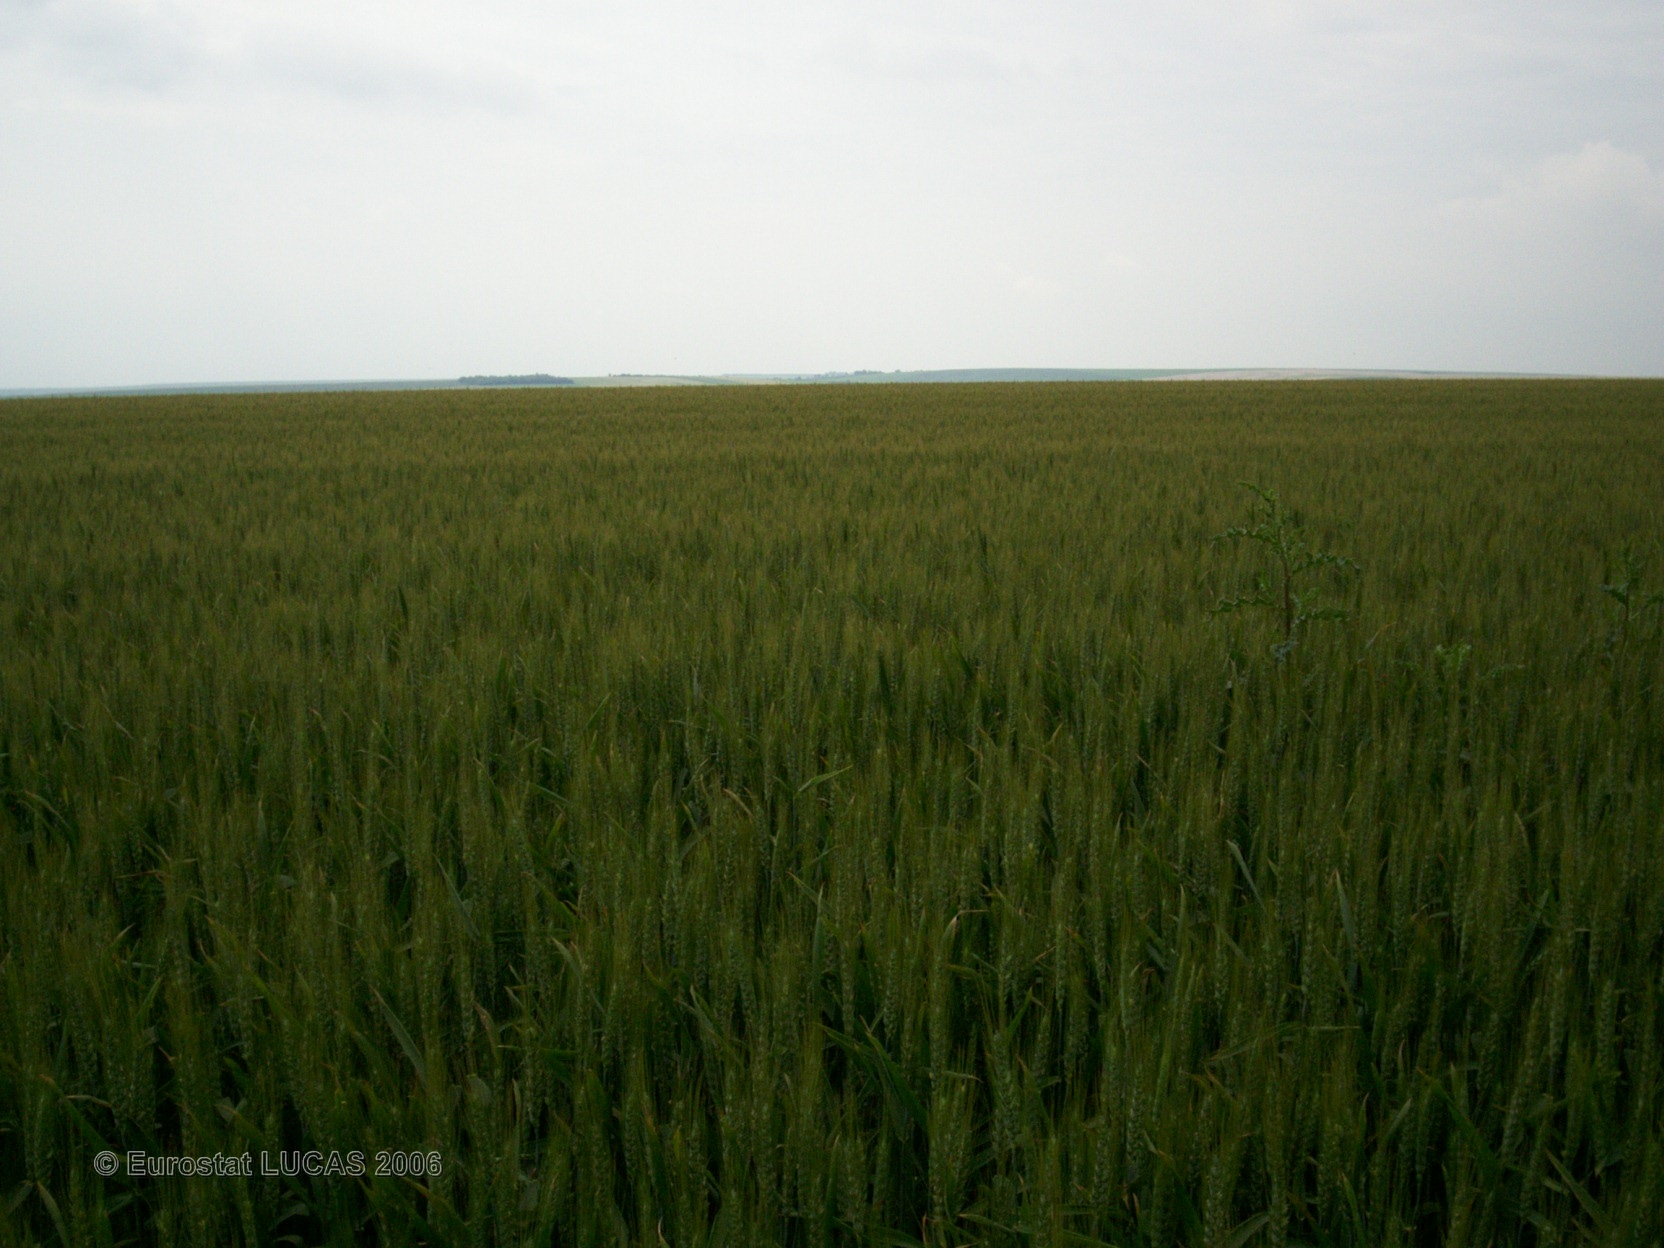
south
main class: Cropland
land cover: Barley
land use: Agriculture (excluding fallow land and kitchen gardens)
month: June
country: FR
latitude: 48.6992
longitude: 4.4942
